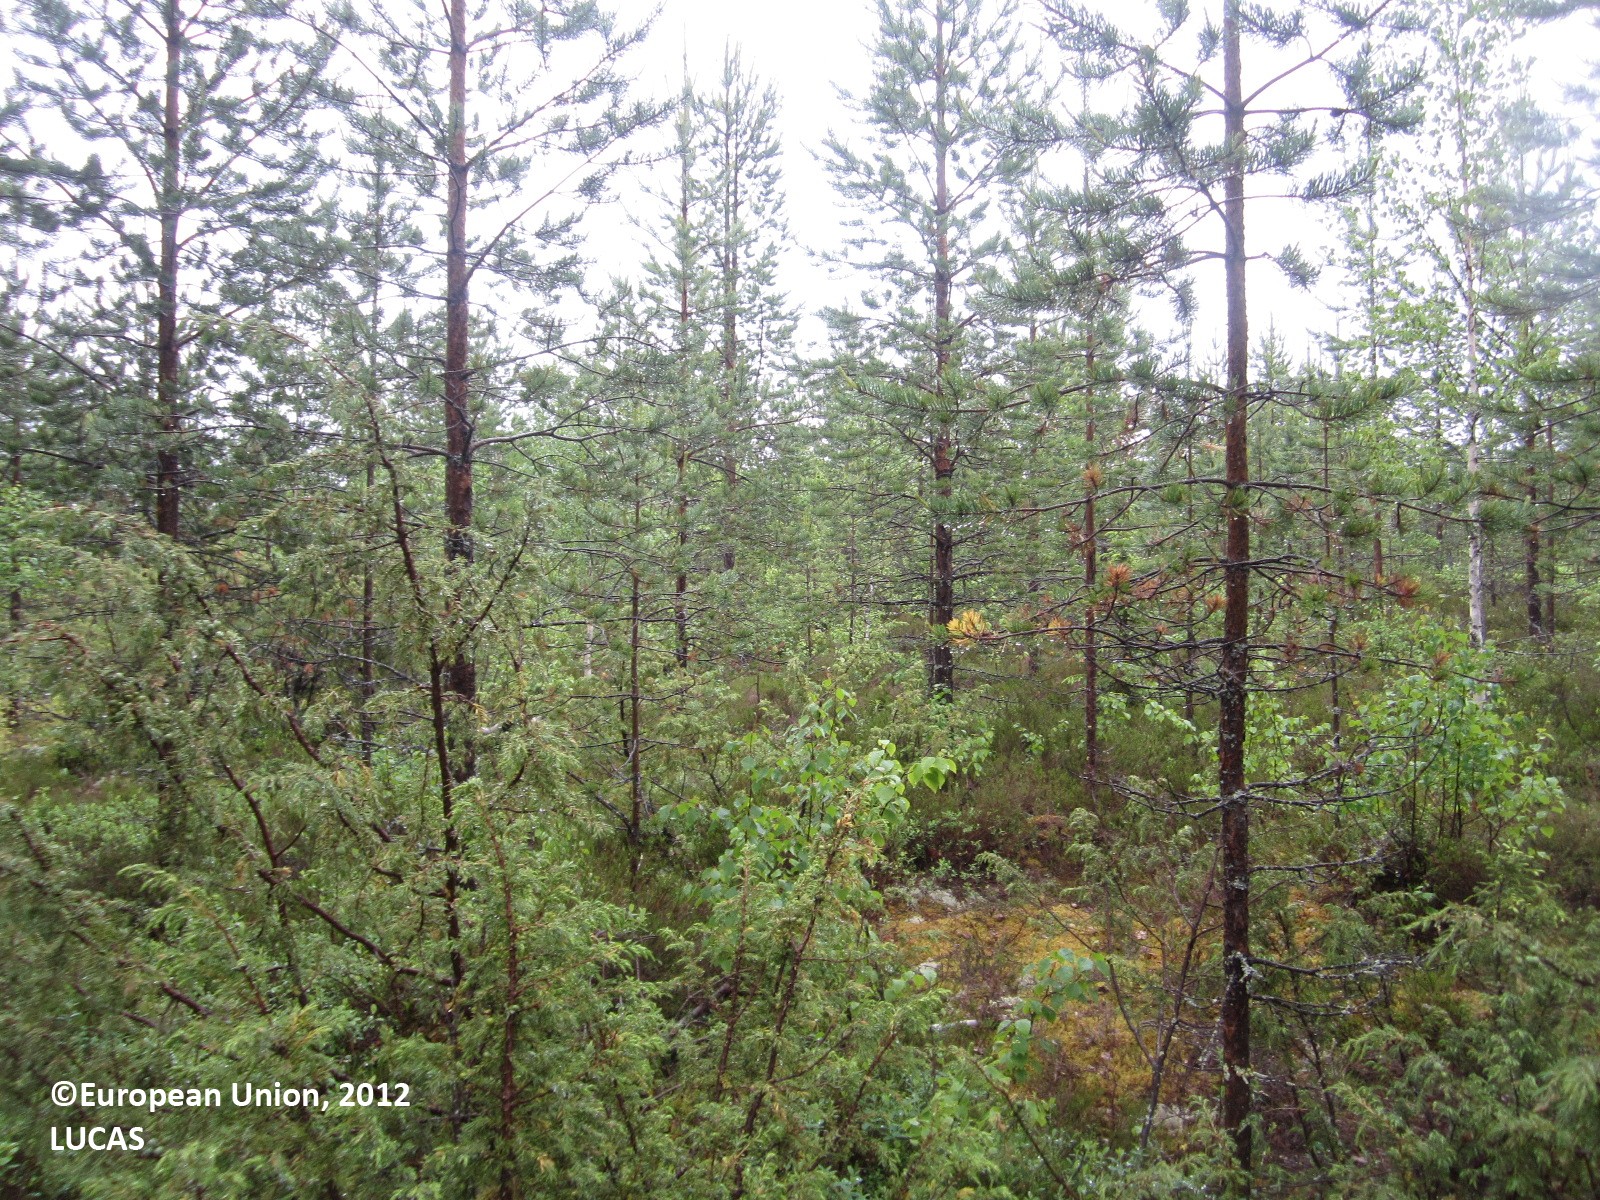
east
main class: Woodland
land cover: Pine dominated coniferous woodland
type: boreal forest
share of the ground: 50 - 75 %
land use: Forestry
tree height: > 5 m
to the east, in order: Pine dominated coniferous woodland; Rock outcrops; Pine dominated coniferous woodland; Pine dominated mixed woodland; Shrubland without tree cover; Pine dominated coniferous woodland; Ditches and canals; Pine dominated mixed woodland
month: June
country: FI
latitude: 64.6626
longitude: 29.2380
